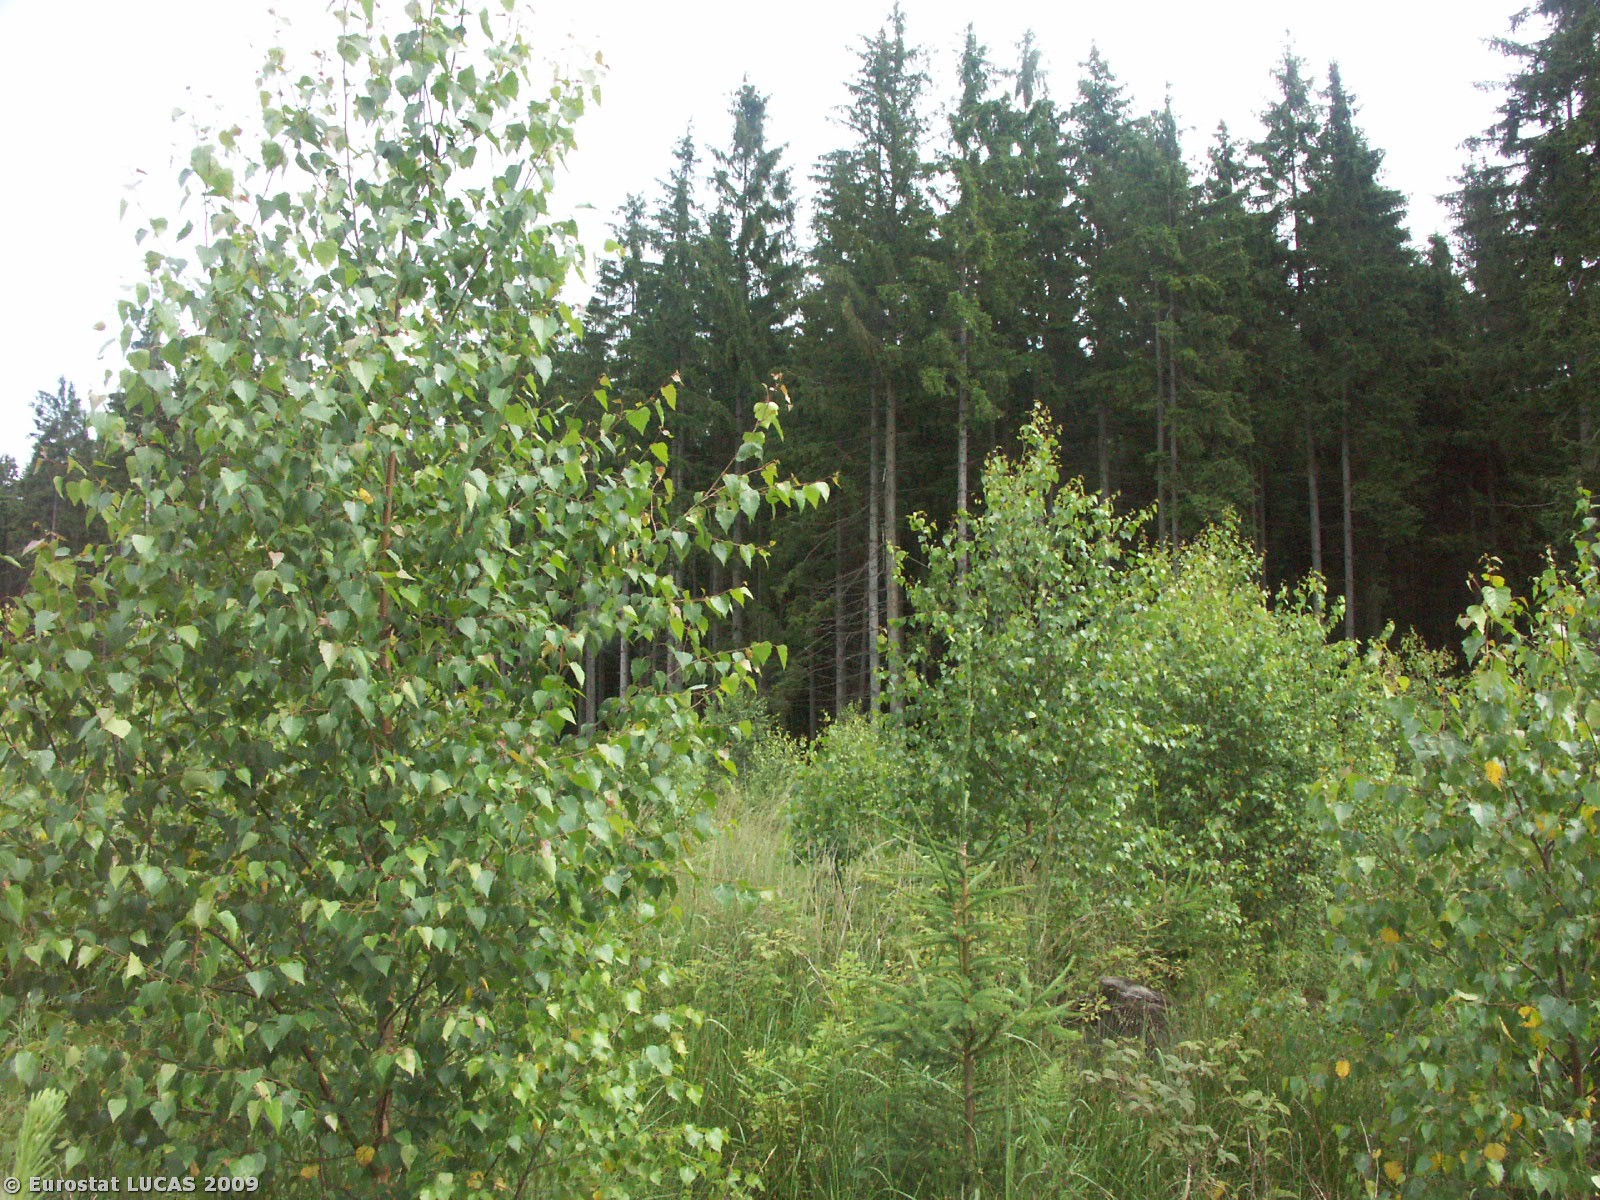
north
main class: Woodland
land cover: Mixed woodland
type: hemiboreal forest and nemoral coniferous forest and mixed broadleaved-coniferous forest
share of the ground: > 75 %
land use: Forestry
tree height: > 5 m
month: July
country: CZ
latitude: 49.9035
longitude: 17.4610
